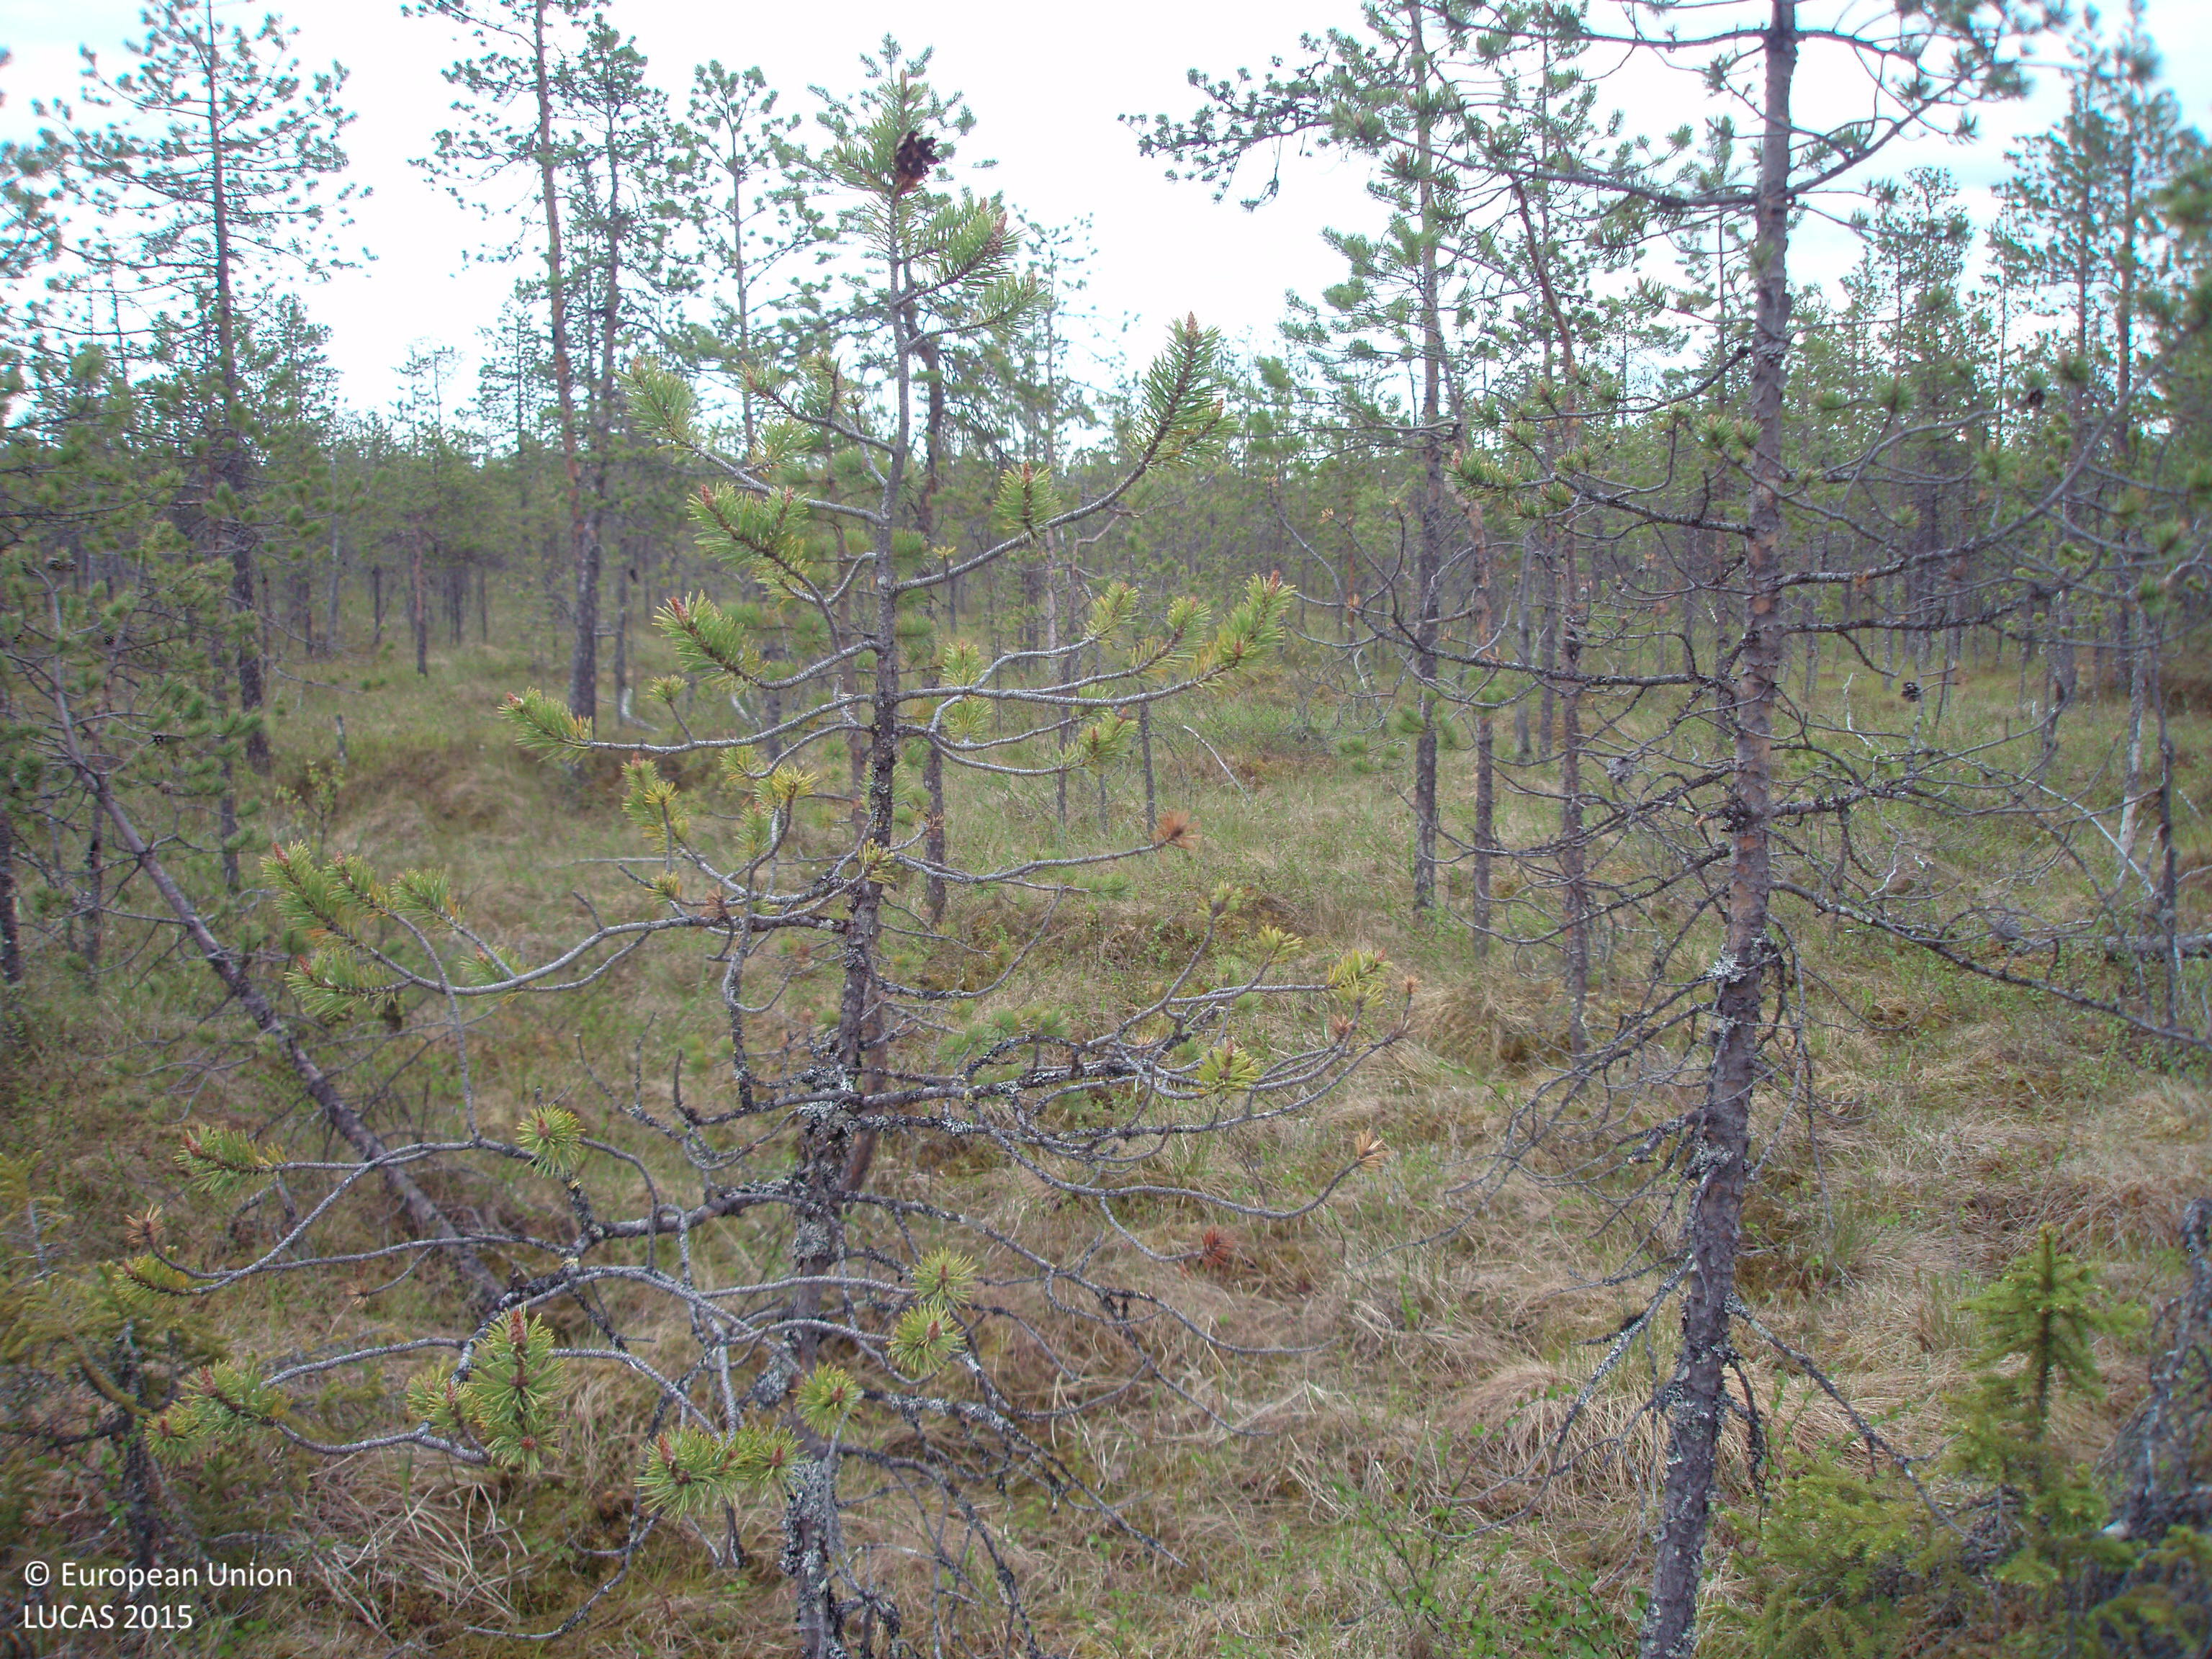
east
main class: Woodland
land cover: Pine dominated coniferous woodland
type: boreal forest
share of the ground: 10 - 25 %
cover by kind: shrubs 50 %, herbaceous plants 30 %, coniferous forest trees 20 %
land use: Semi-natural and natural areas not in use
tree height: > 5 m
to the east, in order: Pine dominated coniferous woodland; Pine dominated mixed woodland; Other mixed woodland; Ditches and canals; Other mixed woodland; Ditches and canals; Other mixed woodland
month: June
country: FI
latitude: 67.2370
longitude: 27.3048
